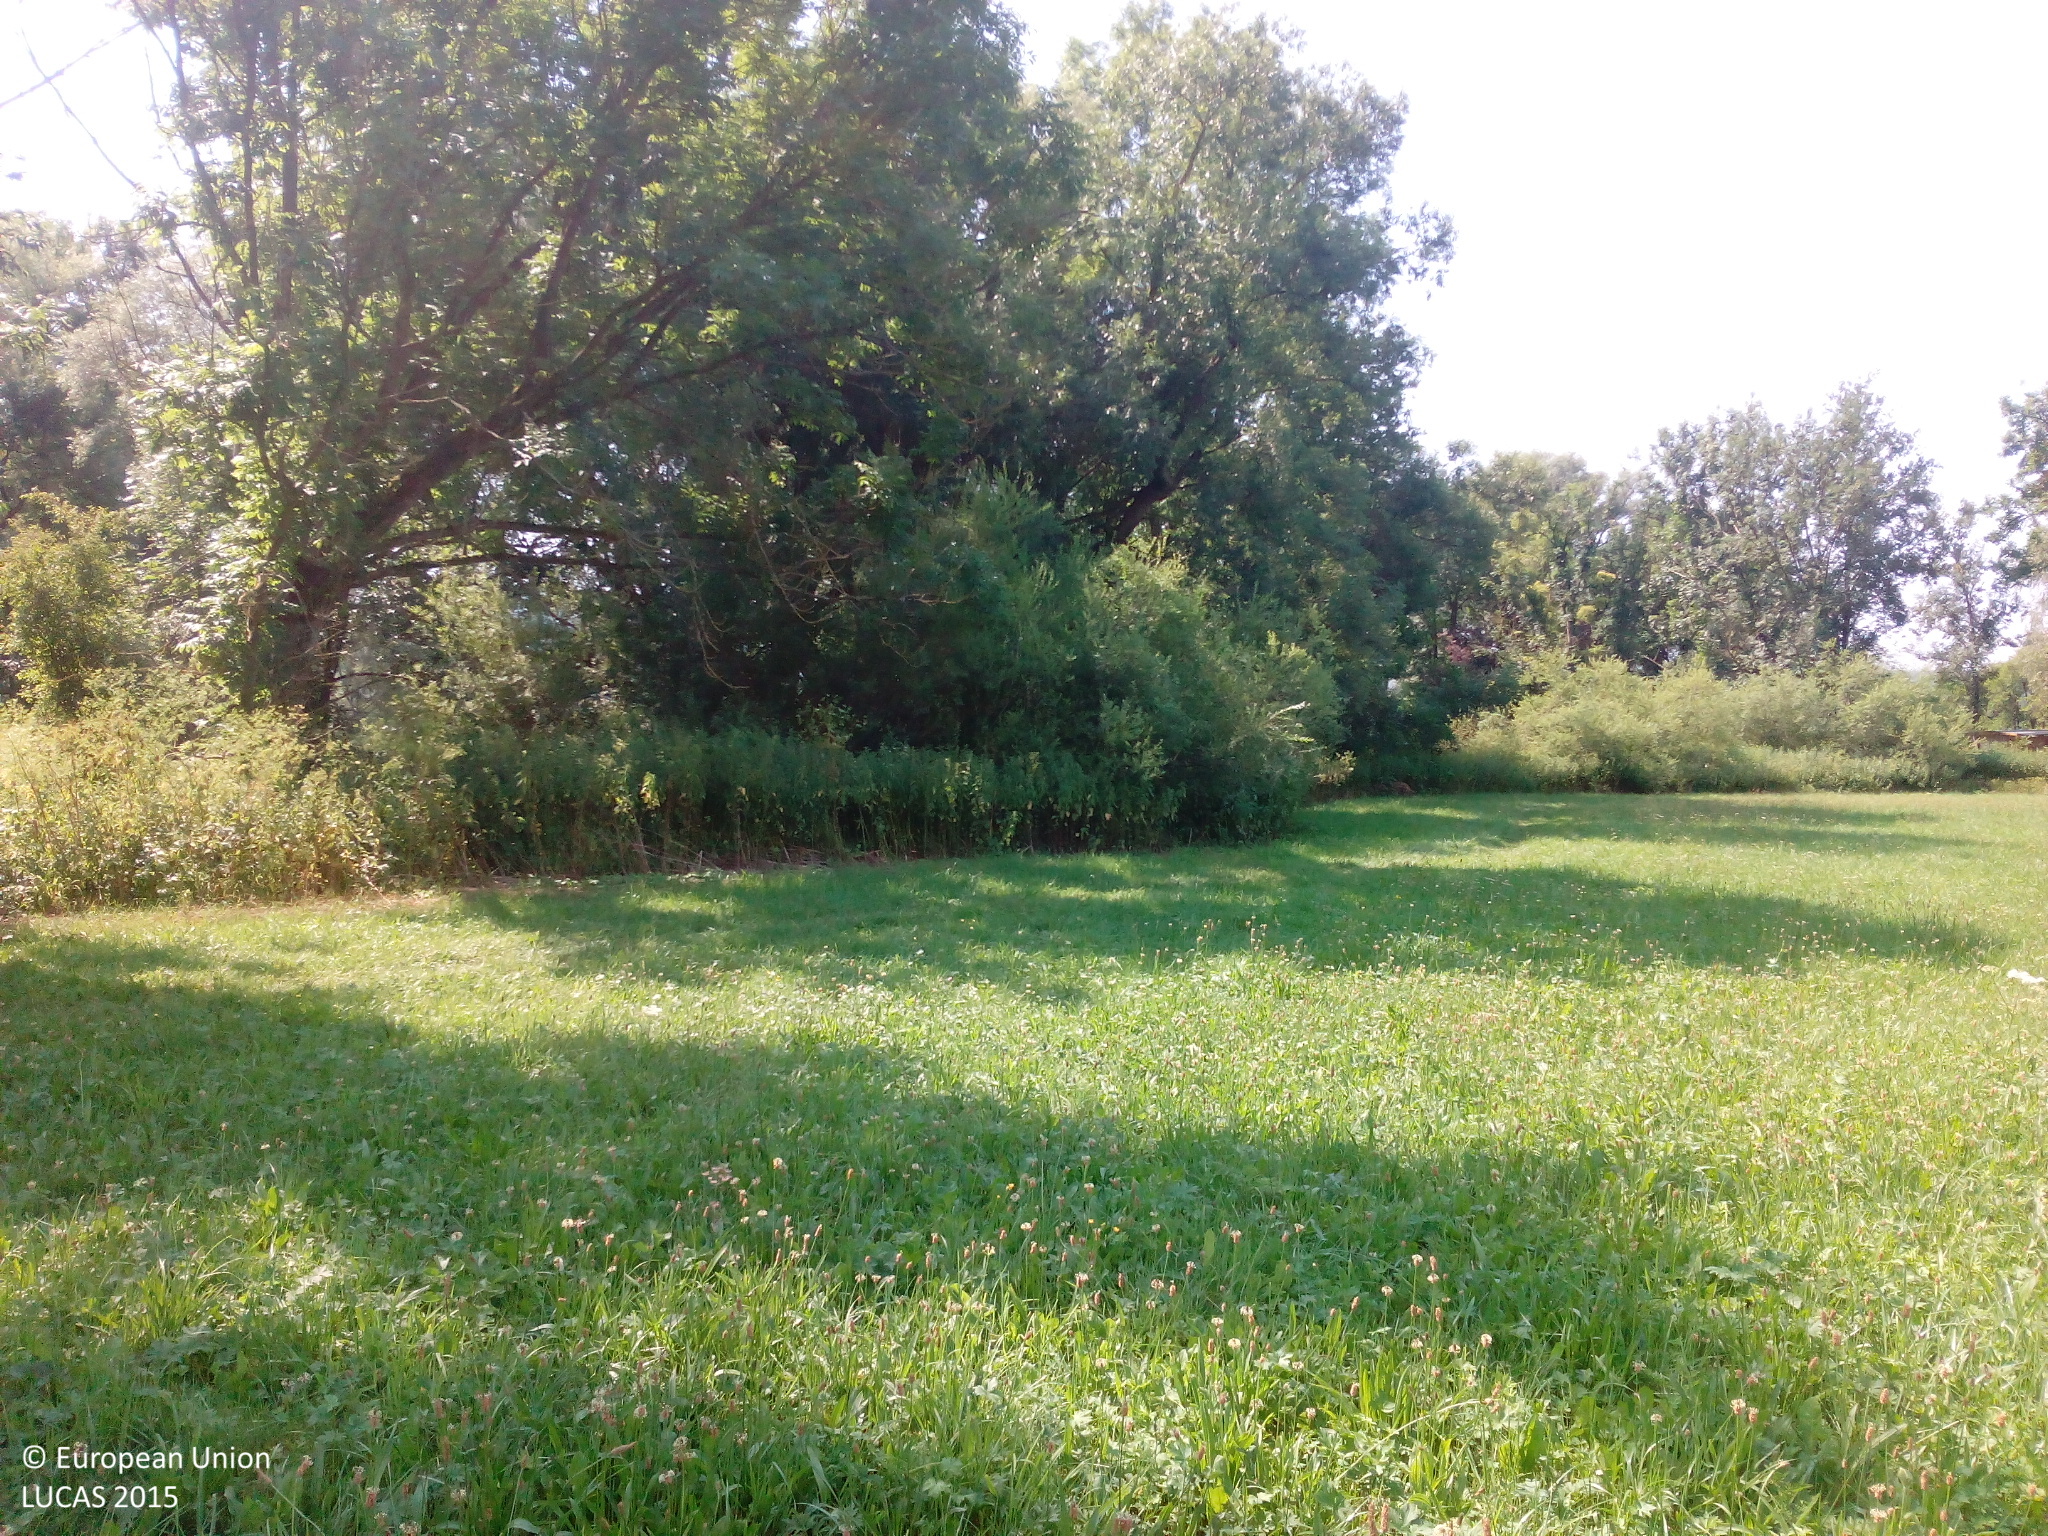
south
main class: Grassland
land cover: Grassland without tree/shrub cover
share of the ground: > 75 %
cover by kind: herbaceous plants 100 %
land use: Agriculture (excluding fallow land and kitchen gardens)
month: July
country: DE
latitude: 49.5095
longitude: 11.4497
